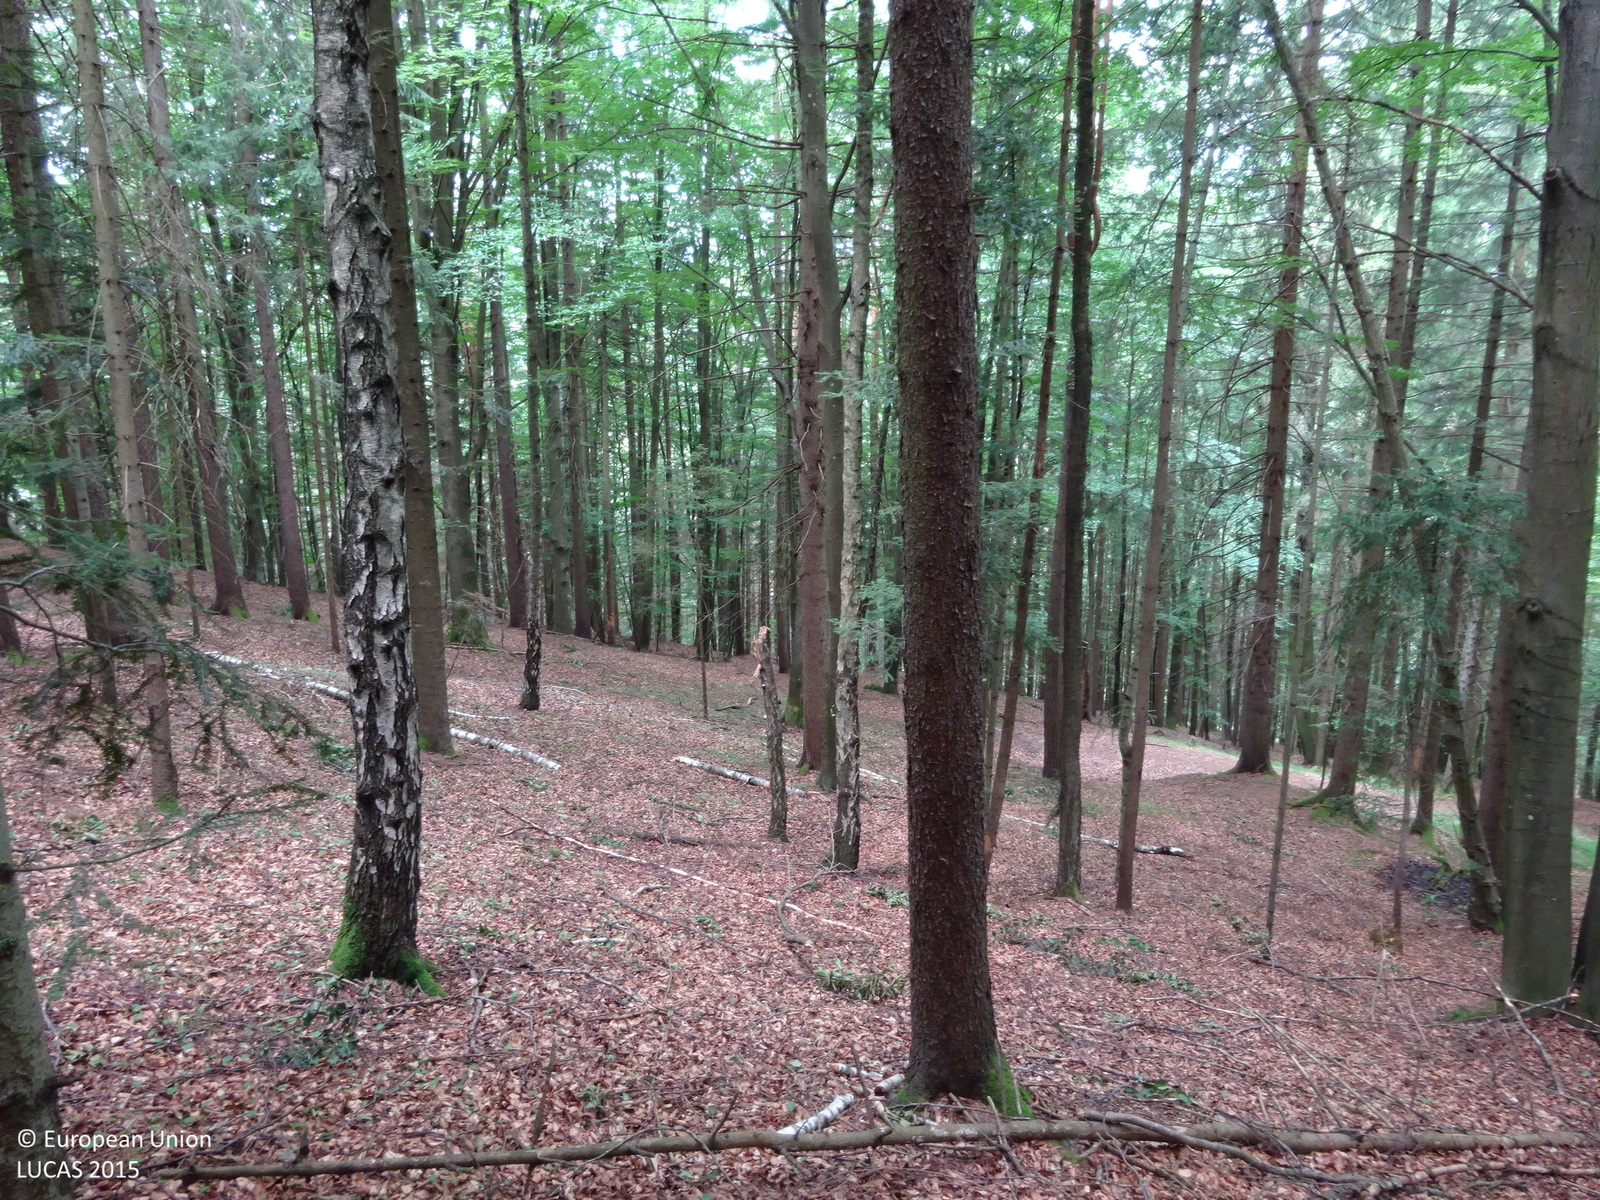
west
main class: Woodland
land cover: Spruce dominated mixed woodland
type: mountainous beech forest
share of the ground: > 75 %
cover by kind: coniferous forest trees 60 %, broadleaved forest trees 40 %
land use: Forestry
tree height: > 5 m
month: July
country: AT
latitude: 47.2573
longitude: 15.4844
